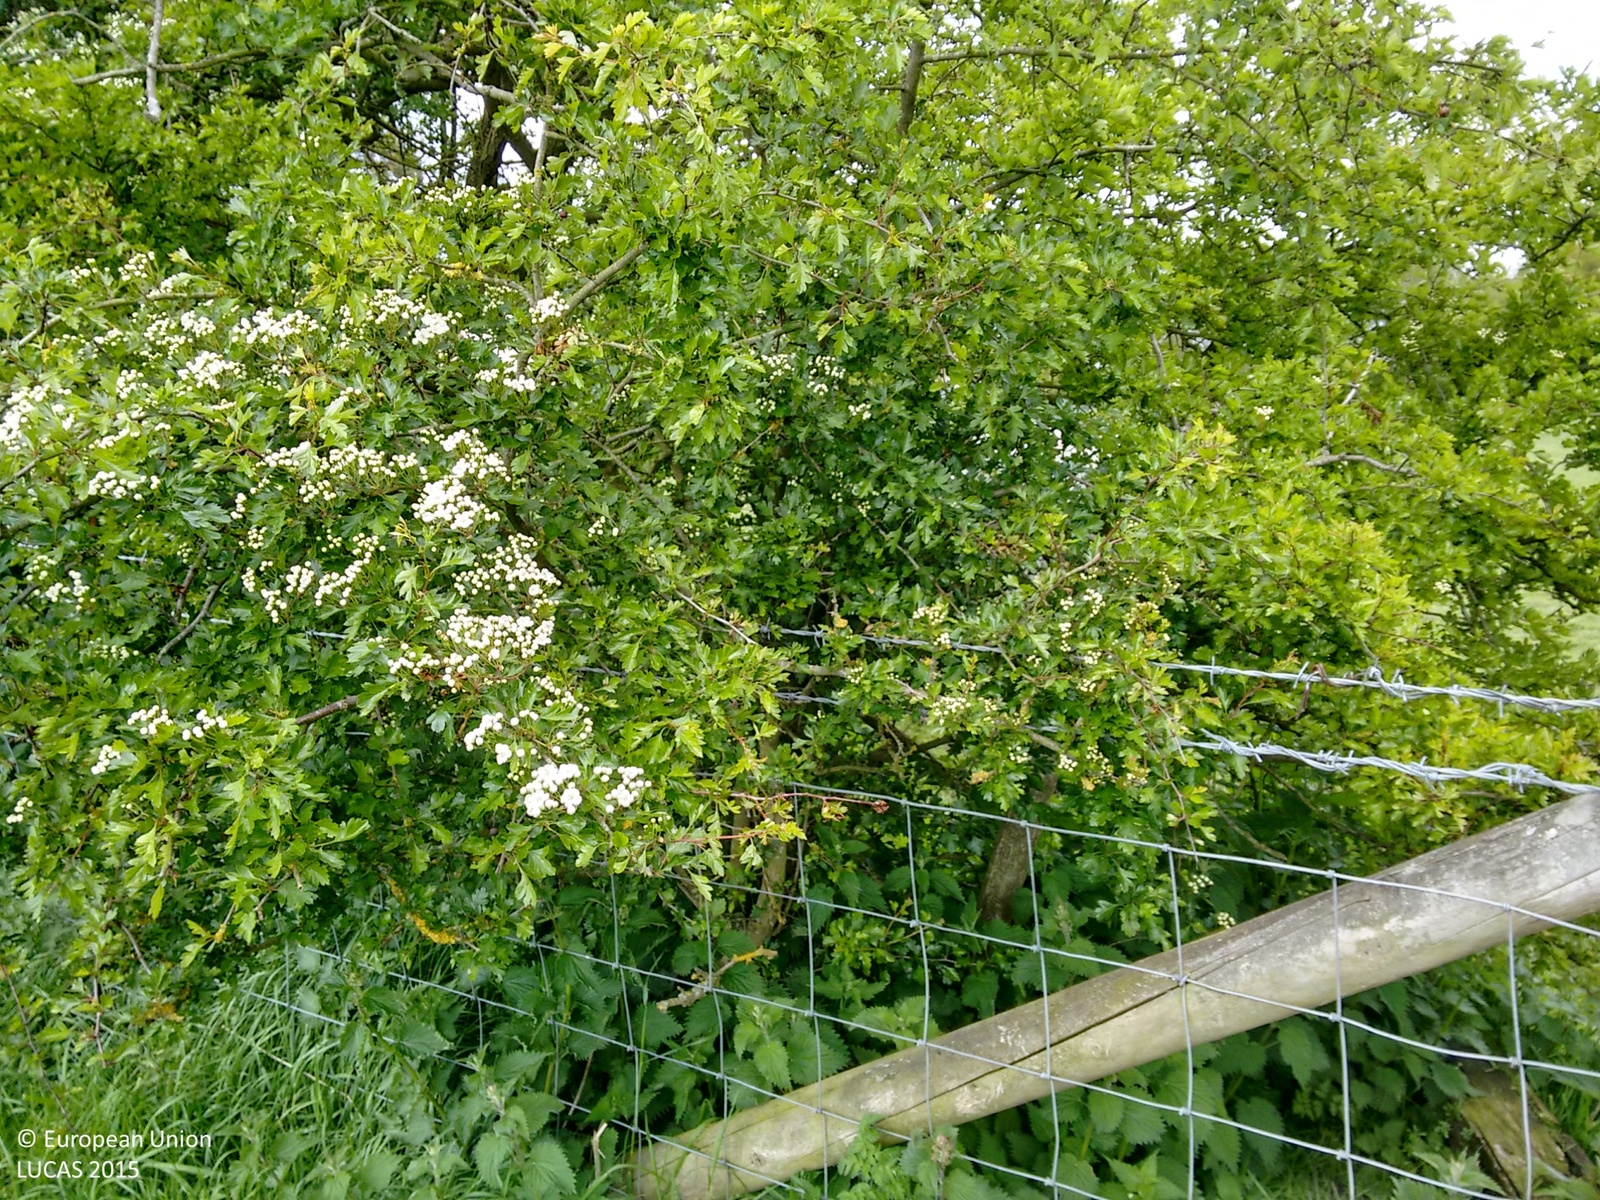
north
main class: Grassland
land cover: Grassland without tree/shrub cover
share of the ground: > 75 %
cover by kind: herbaceous plants 100 %
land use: Agriculture (excluding fallow land and kitchen gardens)
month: May
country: GB
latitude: 53.3657
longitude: -0.2384
